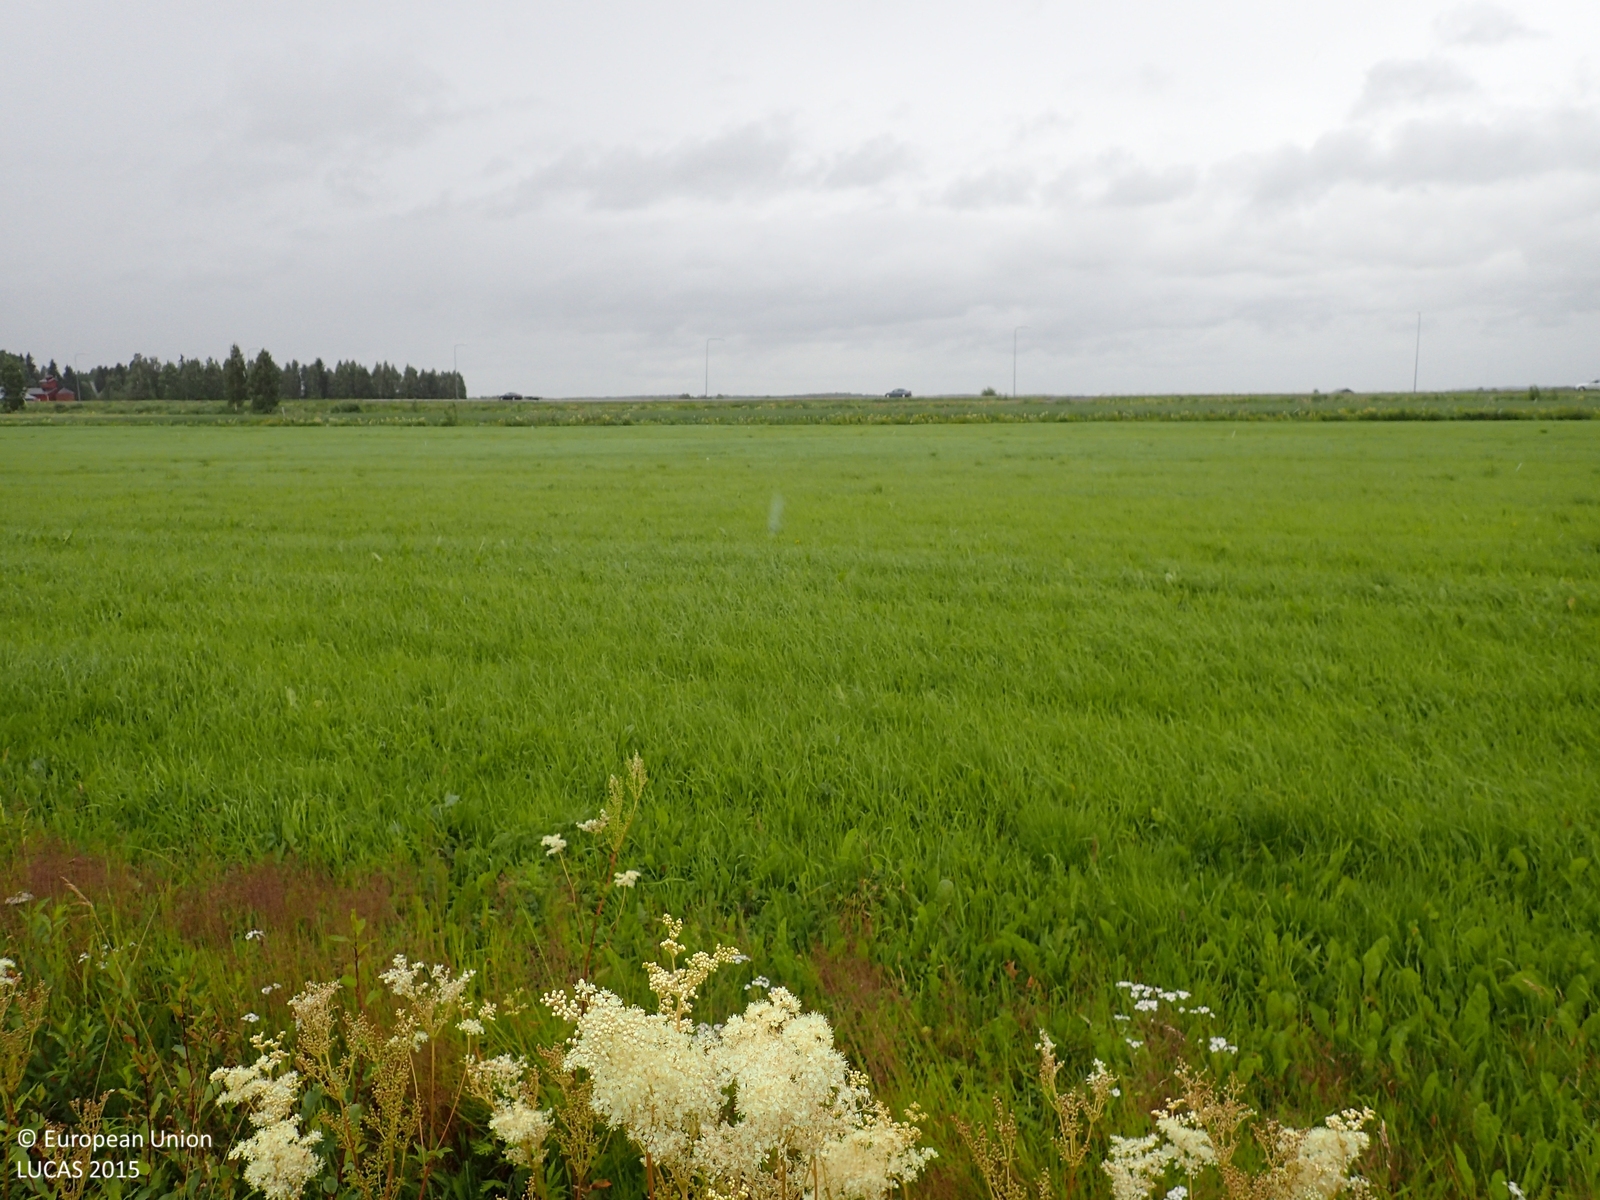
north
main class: Cropland
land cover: Rape and turnip rape
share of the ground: > 75 %
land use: Agriculture (excluding fallow land and kitchen gardens)
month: July
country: FI
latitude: 62.8537
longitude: 22.7671
